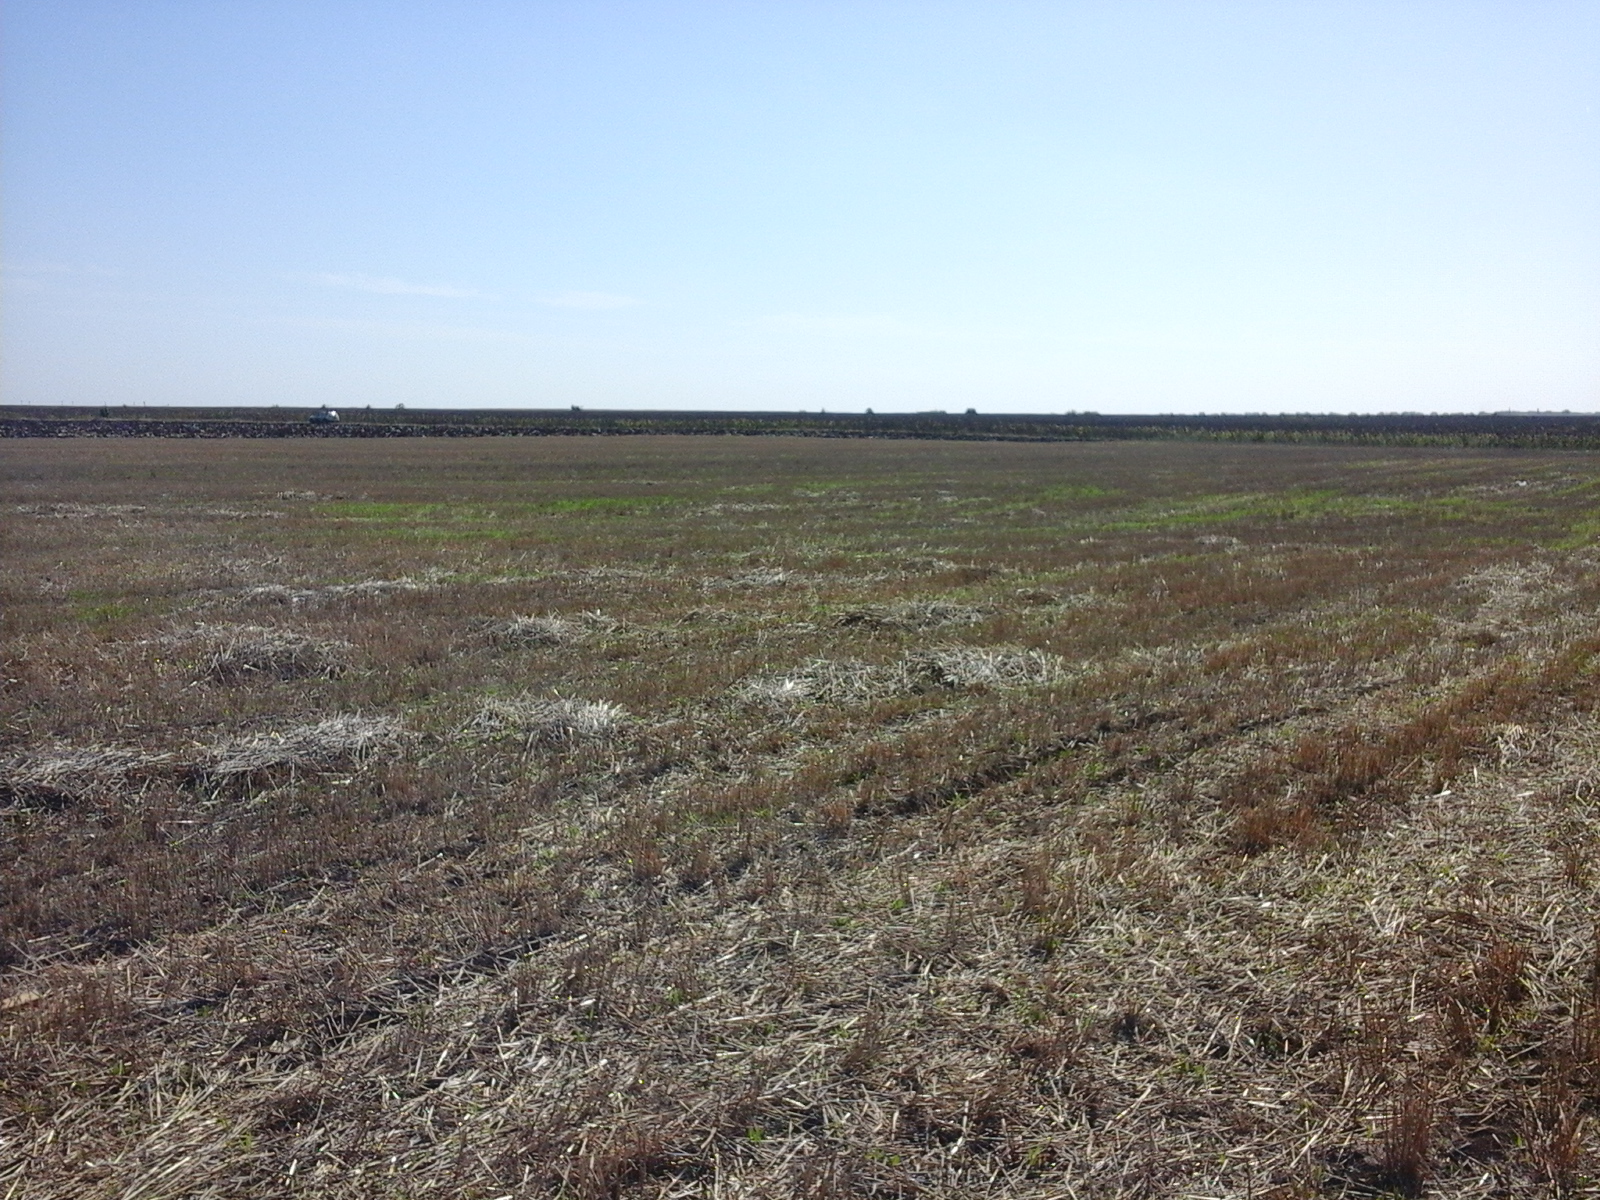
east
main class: Cropland
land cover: Common wheat
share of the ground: 25 - 50 %
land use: Agriculture (excluding fallow land and kitchen gardens)
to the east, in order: Common wheat; Other bare soil; Tracks; Sunflower
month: August
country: RO
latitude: 45.9218
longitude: 21.0541
